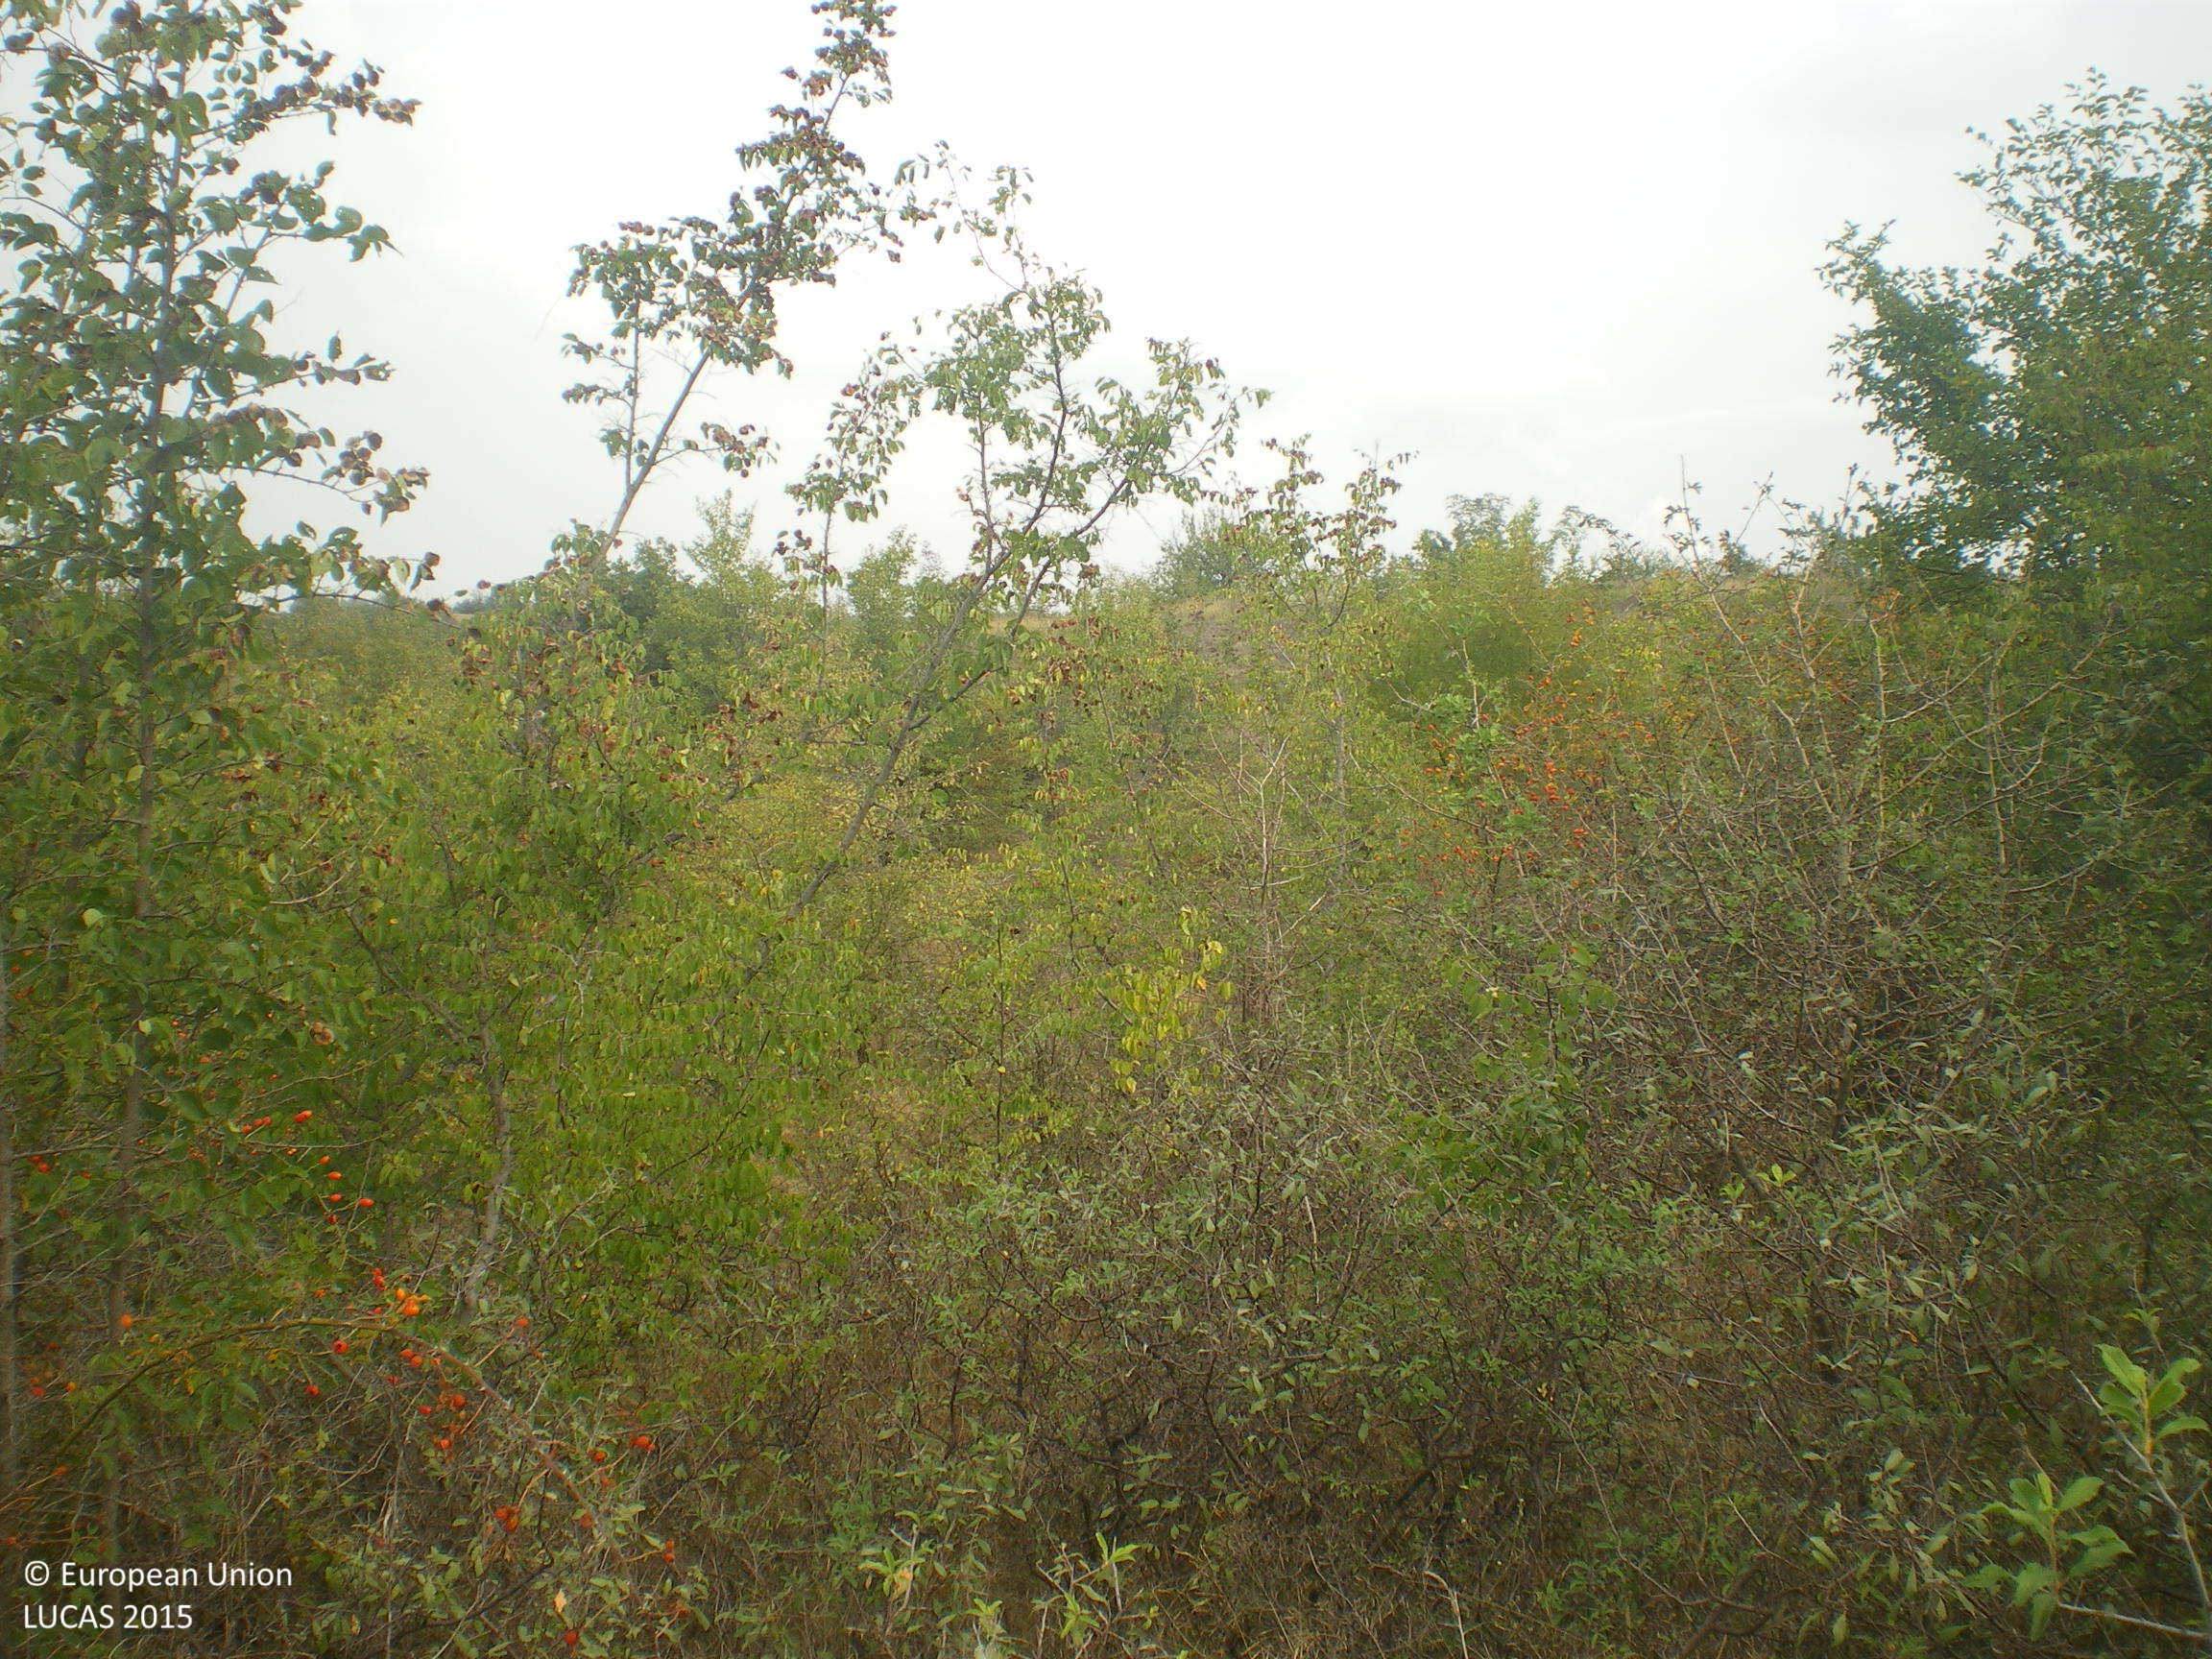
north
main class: Shrubland
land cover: Shrubland with sparse tree cover
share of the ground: > 75 %
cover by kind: shrubs 70 %, herbaceous plants 25 %, broadleaved forest trees 5 %
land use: Semi-natural and natural areas not in use
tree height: > 5 m
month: September
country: BG
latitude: 42.0933
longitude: 25.9740
